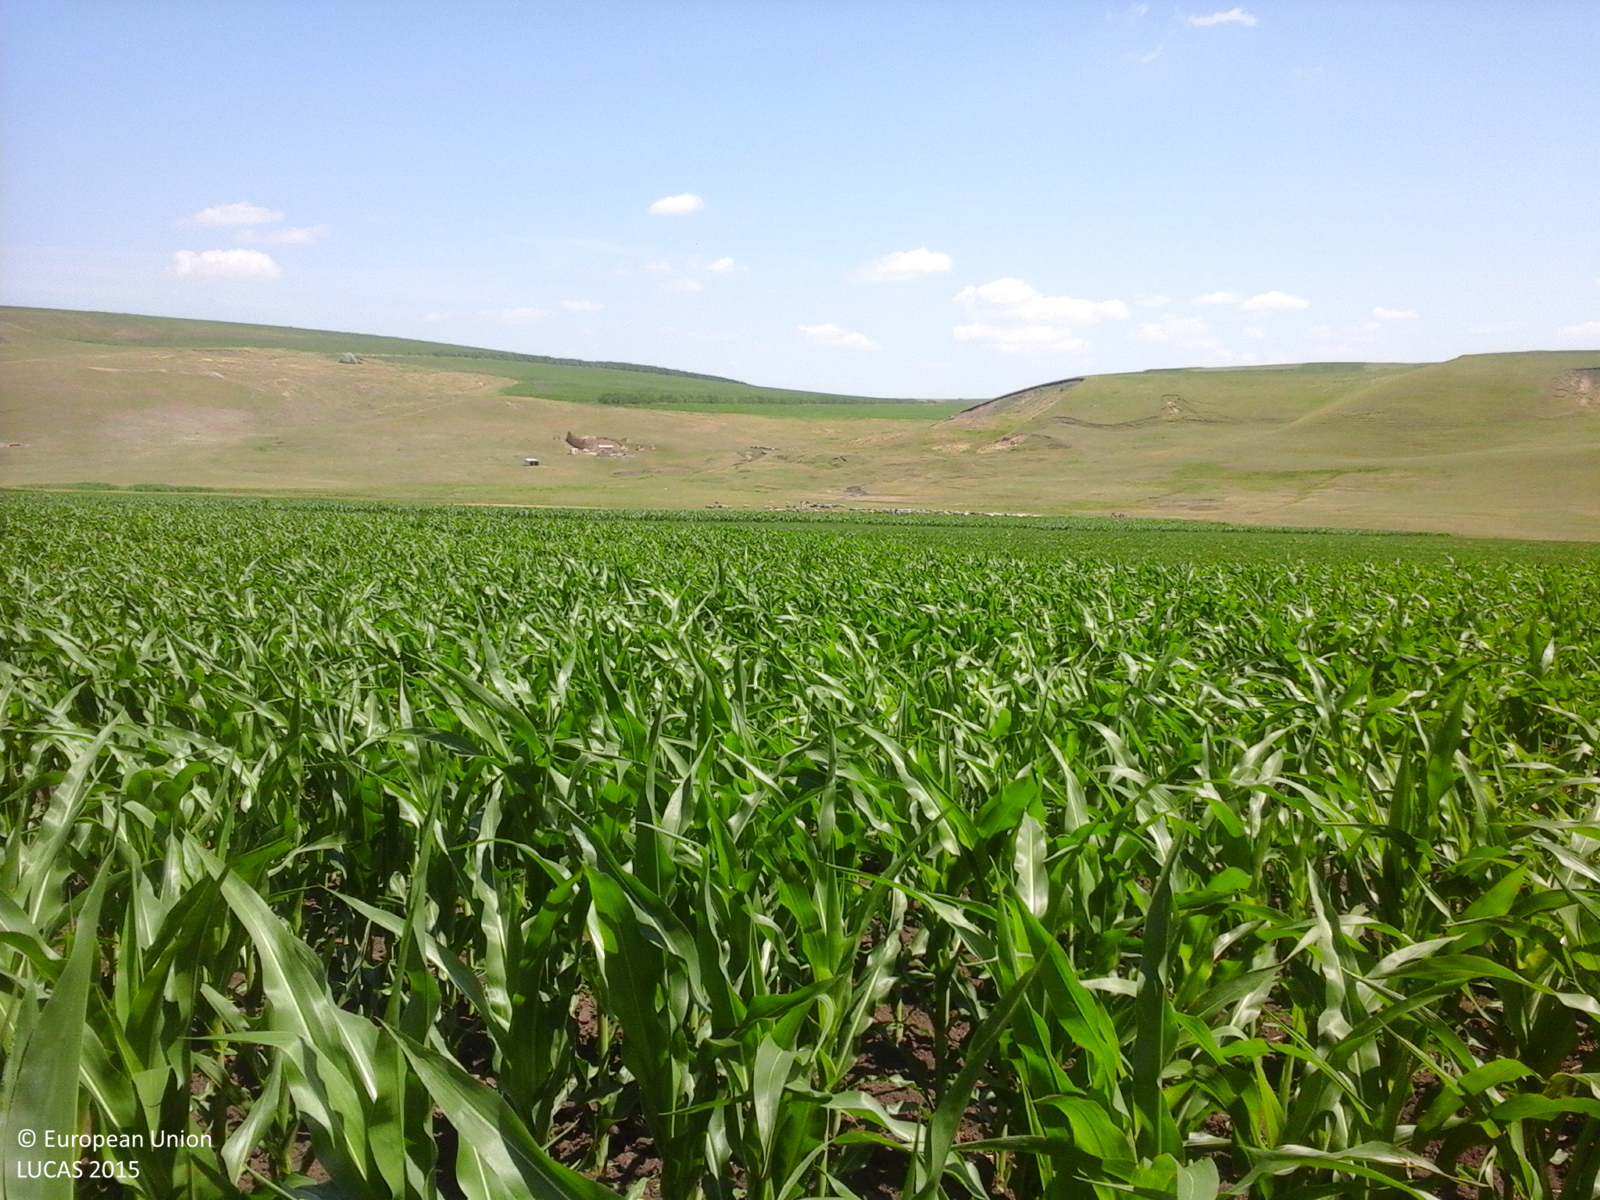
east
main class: Cropland
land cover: Maize
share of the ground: > 75 %
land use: Agriculture (excluding fallow land and kitchen gardens)
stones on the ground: < 10 %
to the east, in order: Maize; Tracks; Lucerne; Maize; Soya; Maize; Soya; Tracks; Soya
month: June
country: RO
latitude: 47.7244
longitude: 27.1885
